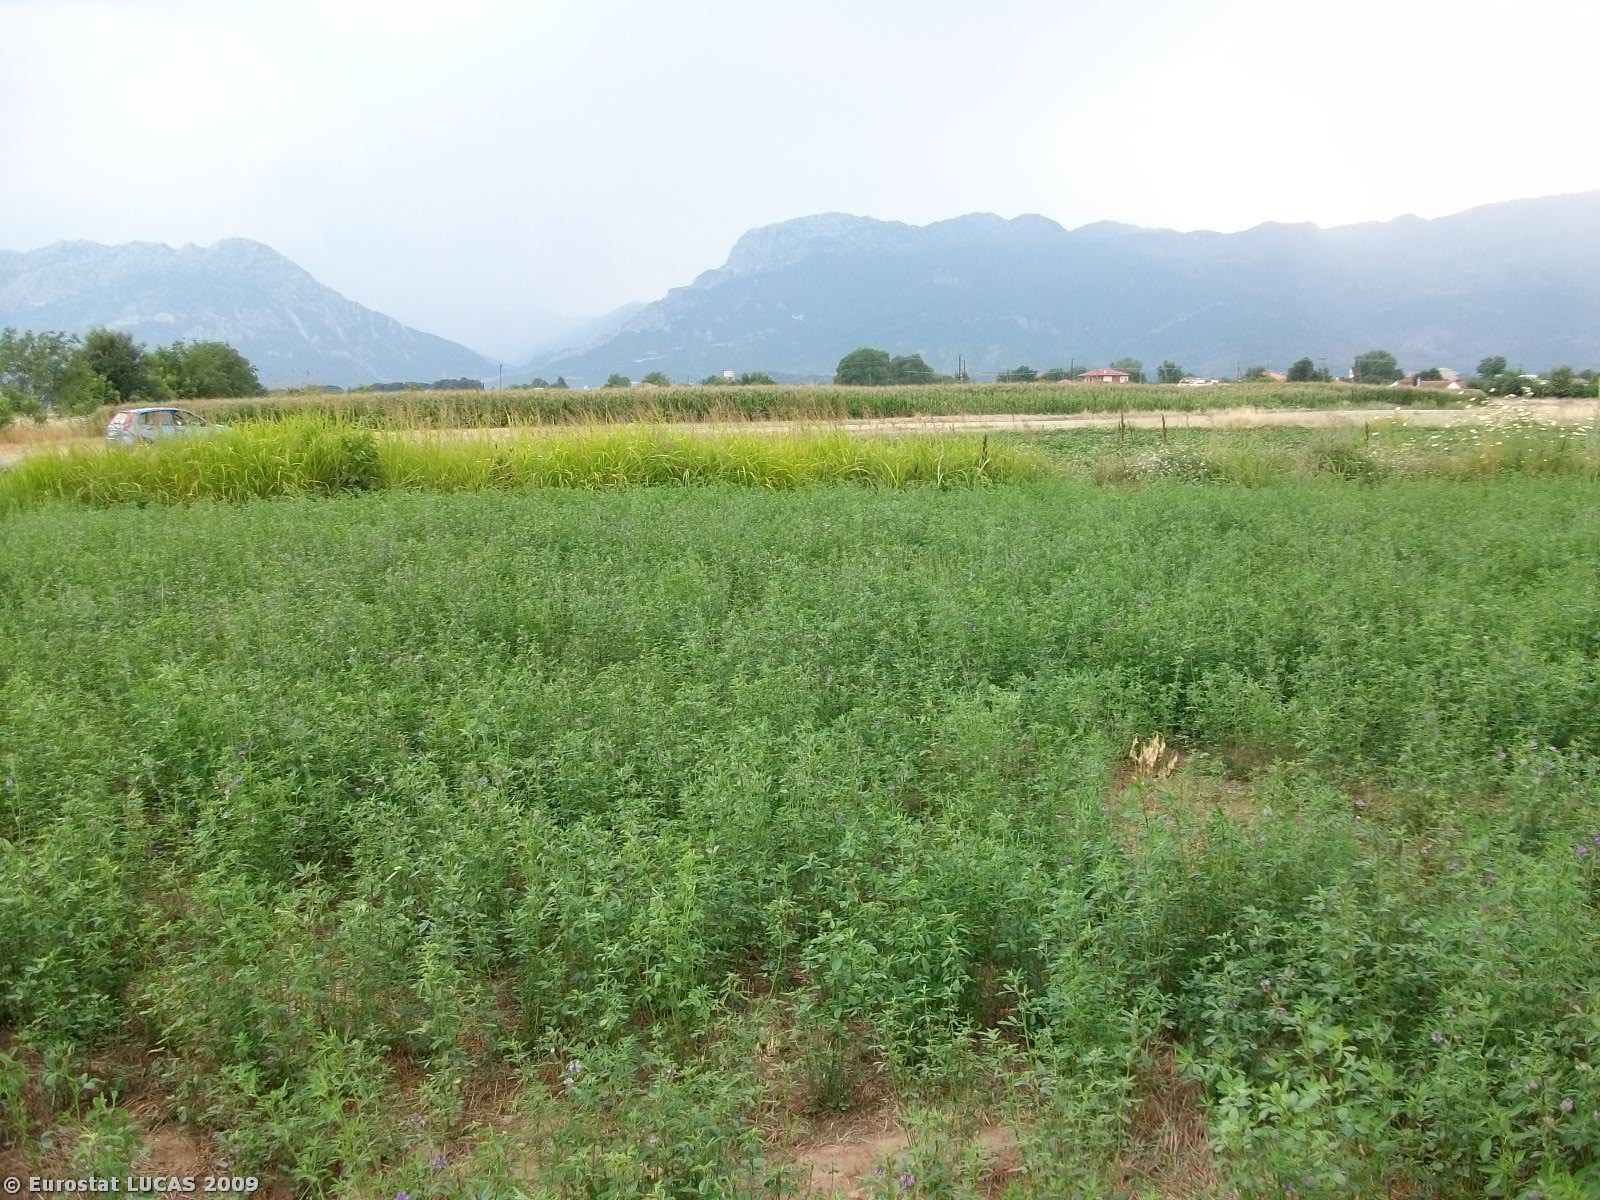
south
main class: Cropland
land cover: Clovers
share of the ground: > 75 %
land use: Agriculture (excluding fallow land and kitchen gardens)
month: July
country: GR
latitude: 39.4927
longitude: 21.6912
